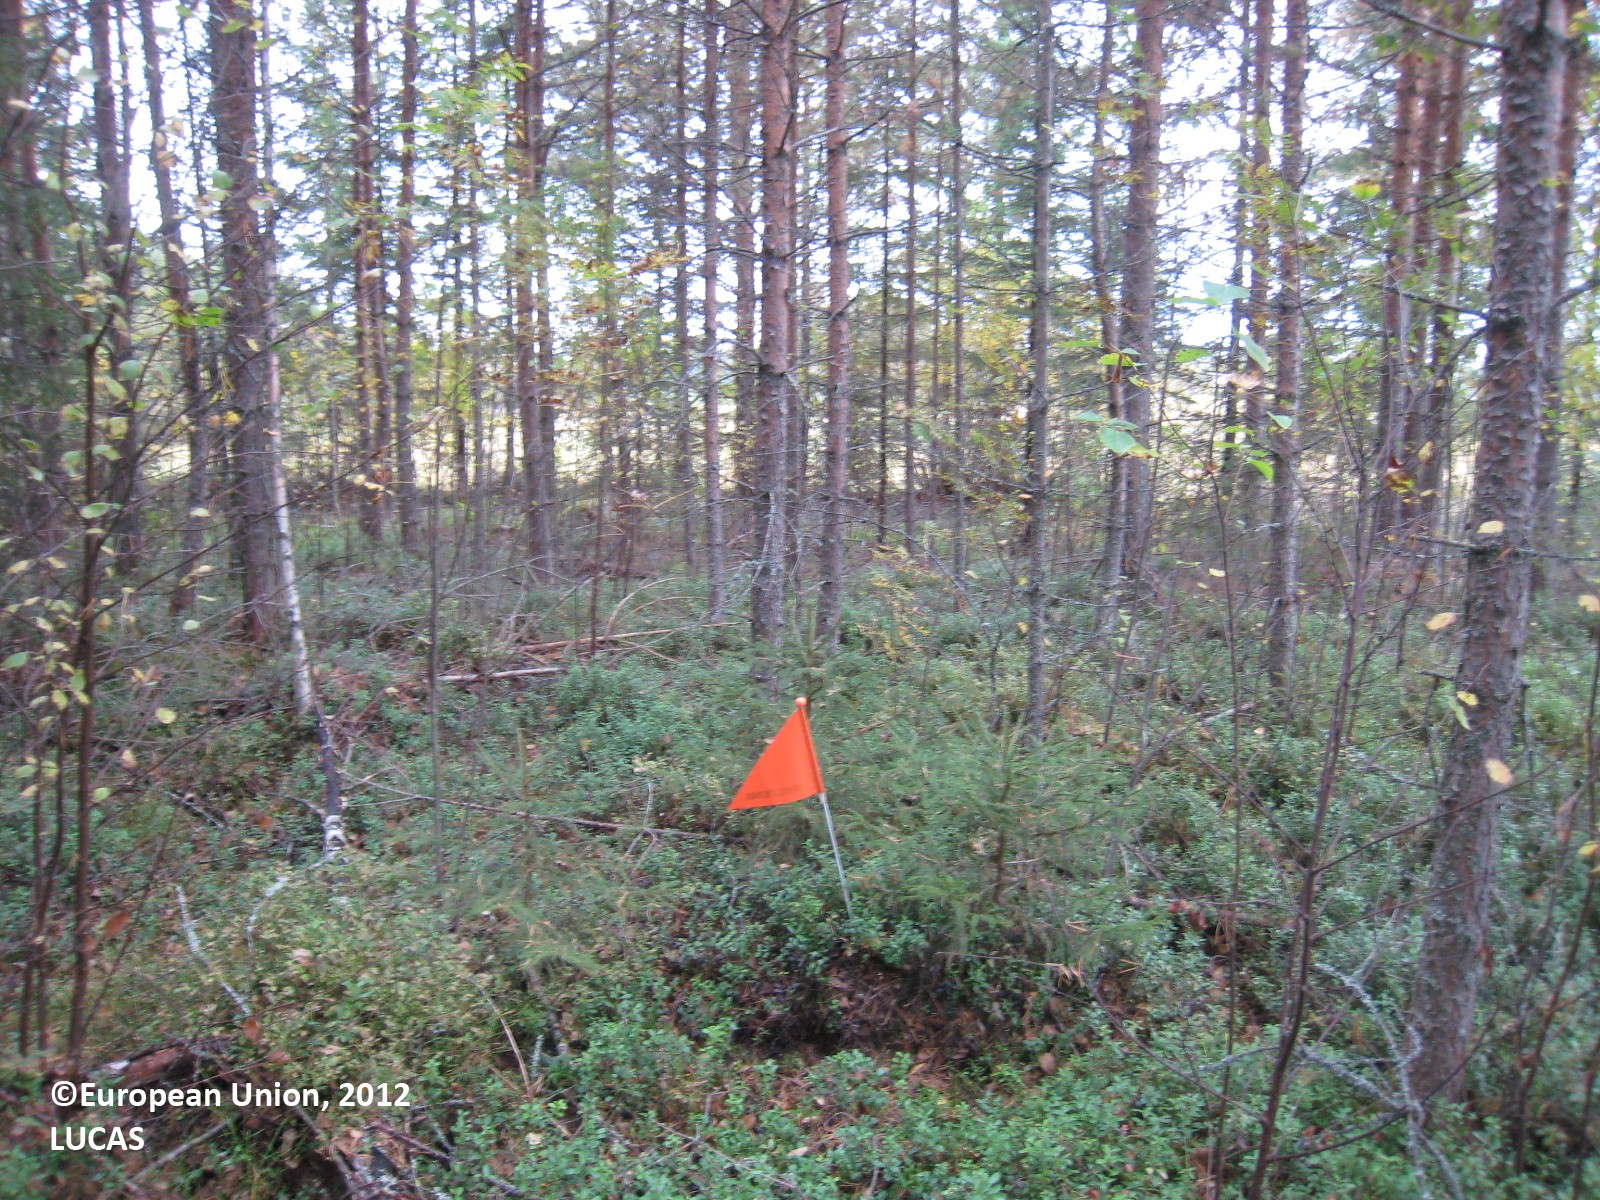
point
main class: Woodland
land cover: Pine dominated coniferous woodland
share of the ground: > 75 %
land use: Forestry
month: September
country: FI
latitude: 62.6932
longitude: 26.6501
